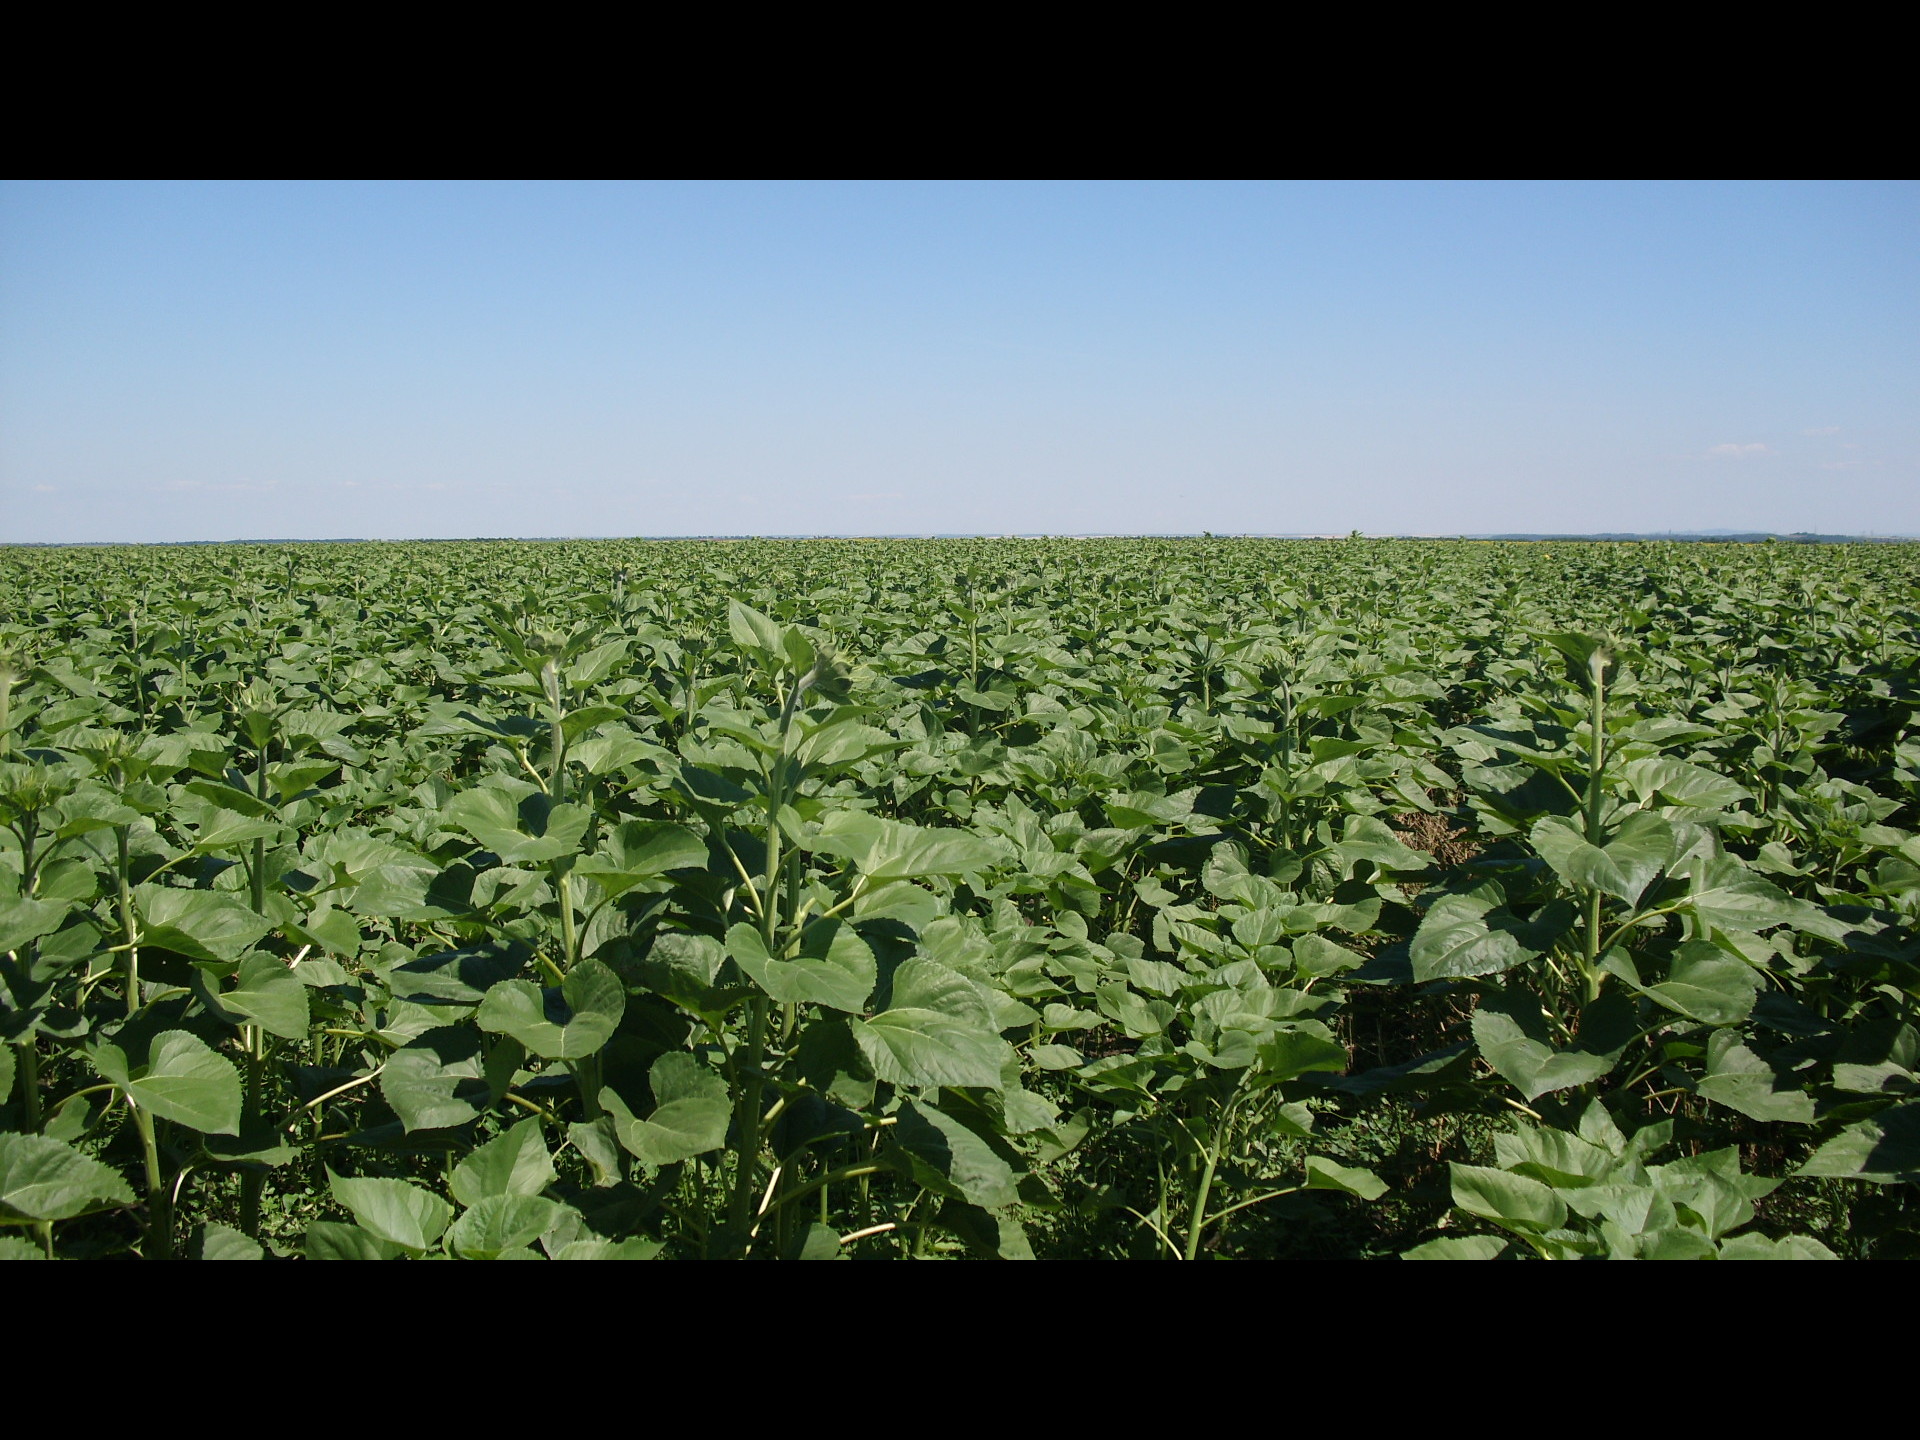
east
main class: Cropland
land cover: Sunflower
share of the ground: > 75 %
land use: Agriculture (excluding fallow land and kitchen gardens)
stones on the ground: < 10 %
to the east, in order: Sunflower; Grass margins; Sunflower
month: June
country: BG
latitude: 43.5598
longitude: 23.3259
